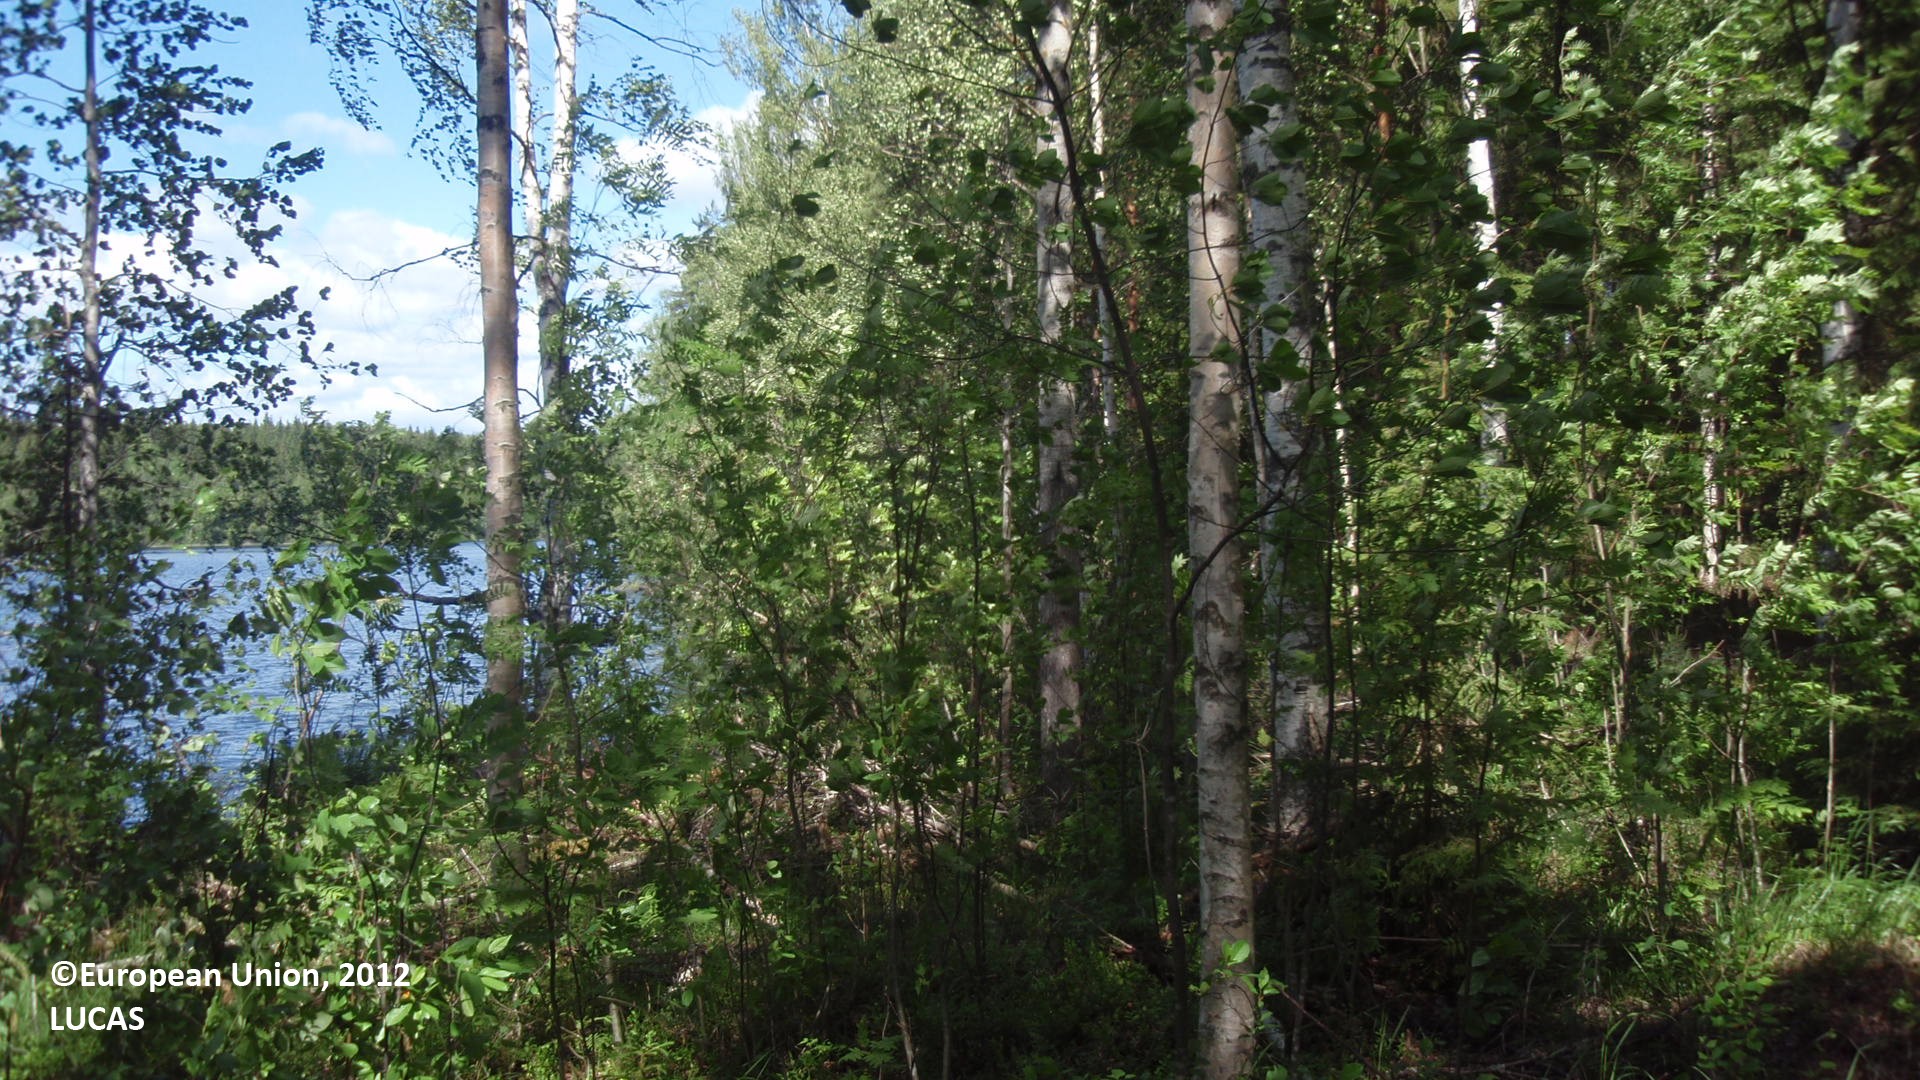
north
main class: Woodland
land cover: Spruce dominated mixed woodland
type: boreal forest
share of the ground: 50 - 75 %
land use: Forestry
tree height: > 5 m
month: June
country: FI
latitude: 61.5974
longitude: 26.6792
